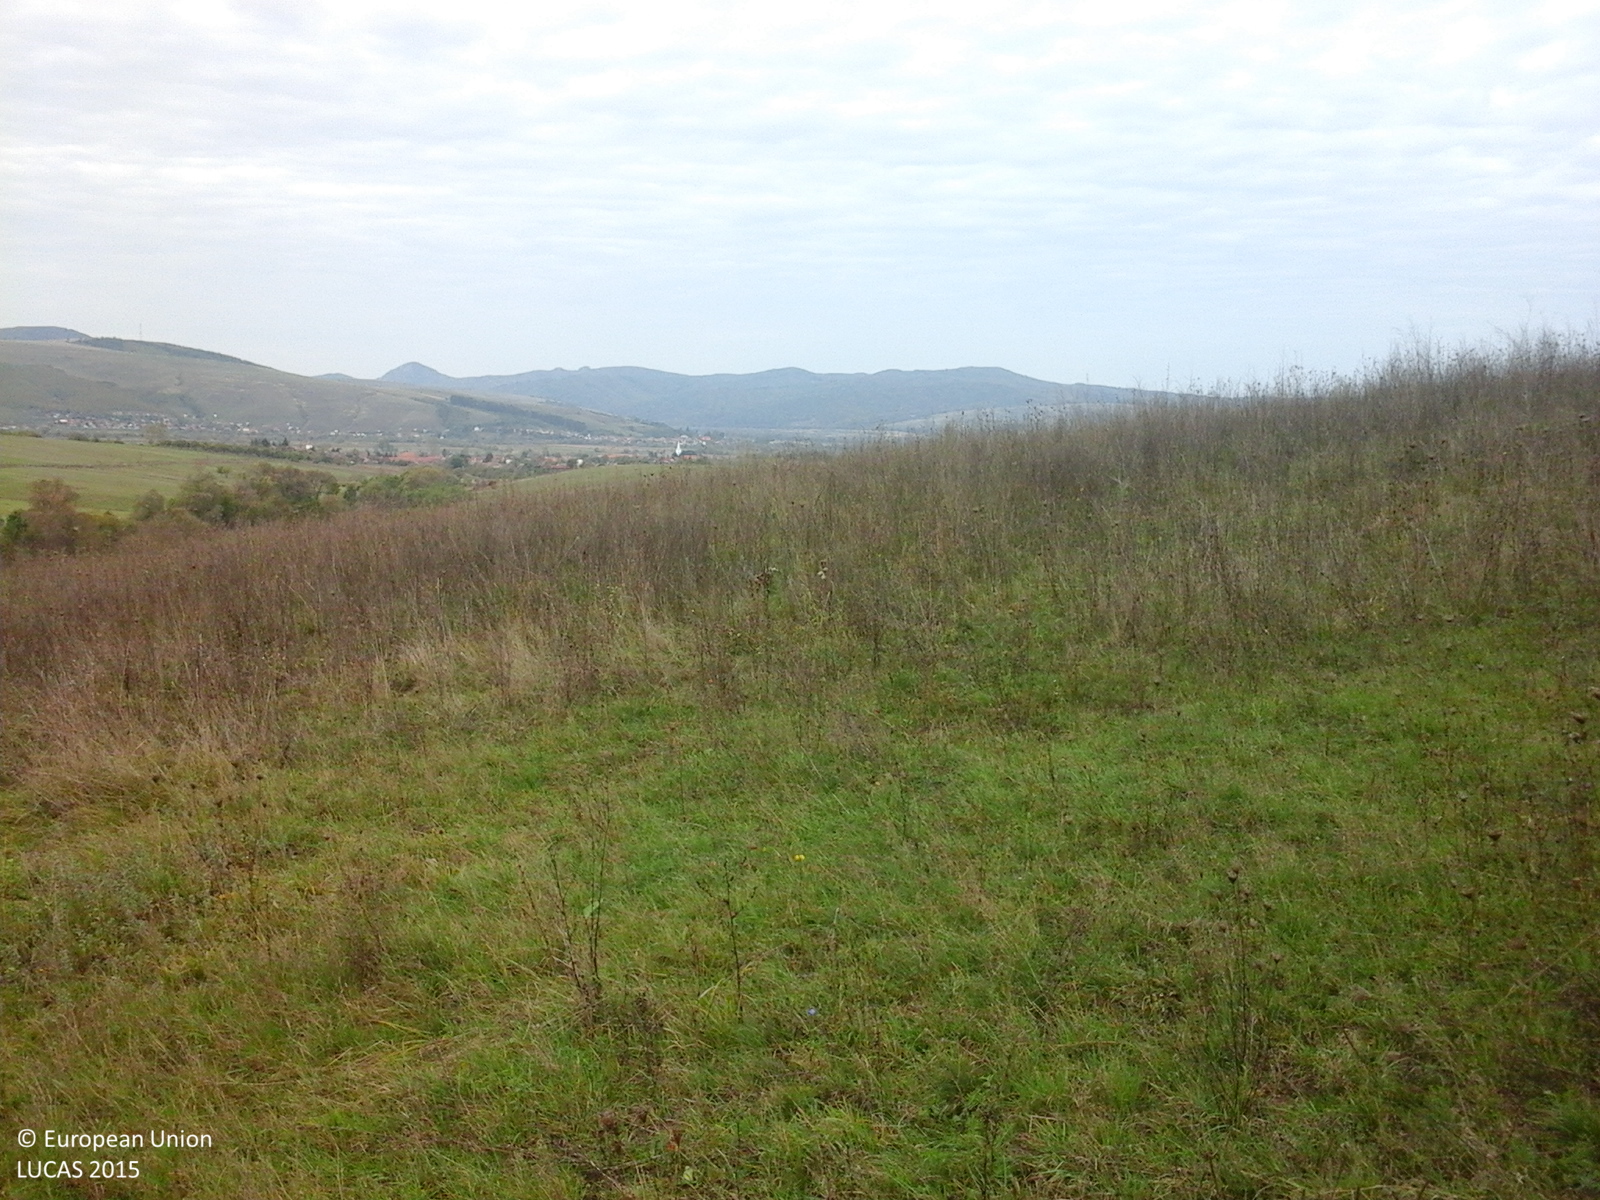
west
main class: Grassland
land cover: Grassland without tree/shrub cover
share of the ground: > 75 %
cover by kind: herbaceous plants 100 %
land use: Agriculture (excluding fallow land and kitchen gardens)
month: October
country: RO
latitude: 46.0408
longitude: 25.6011
